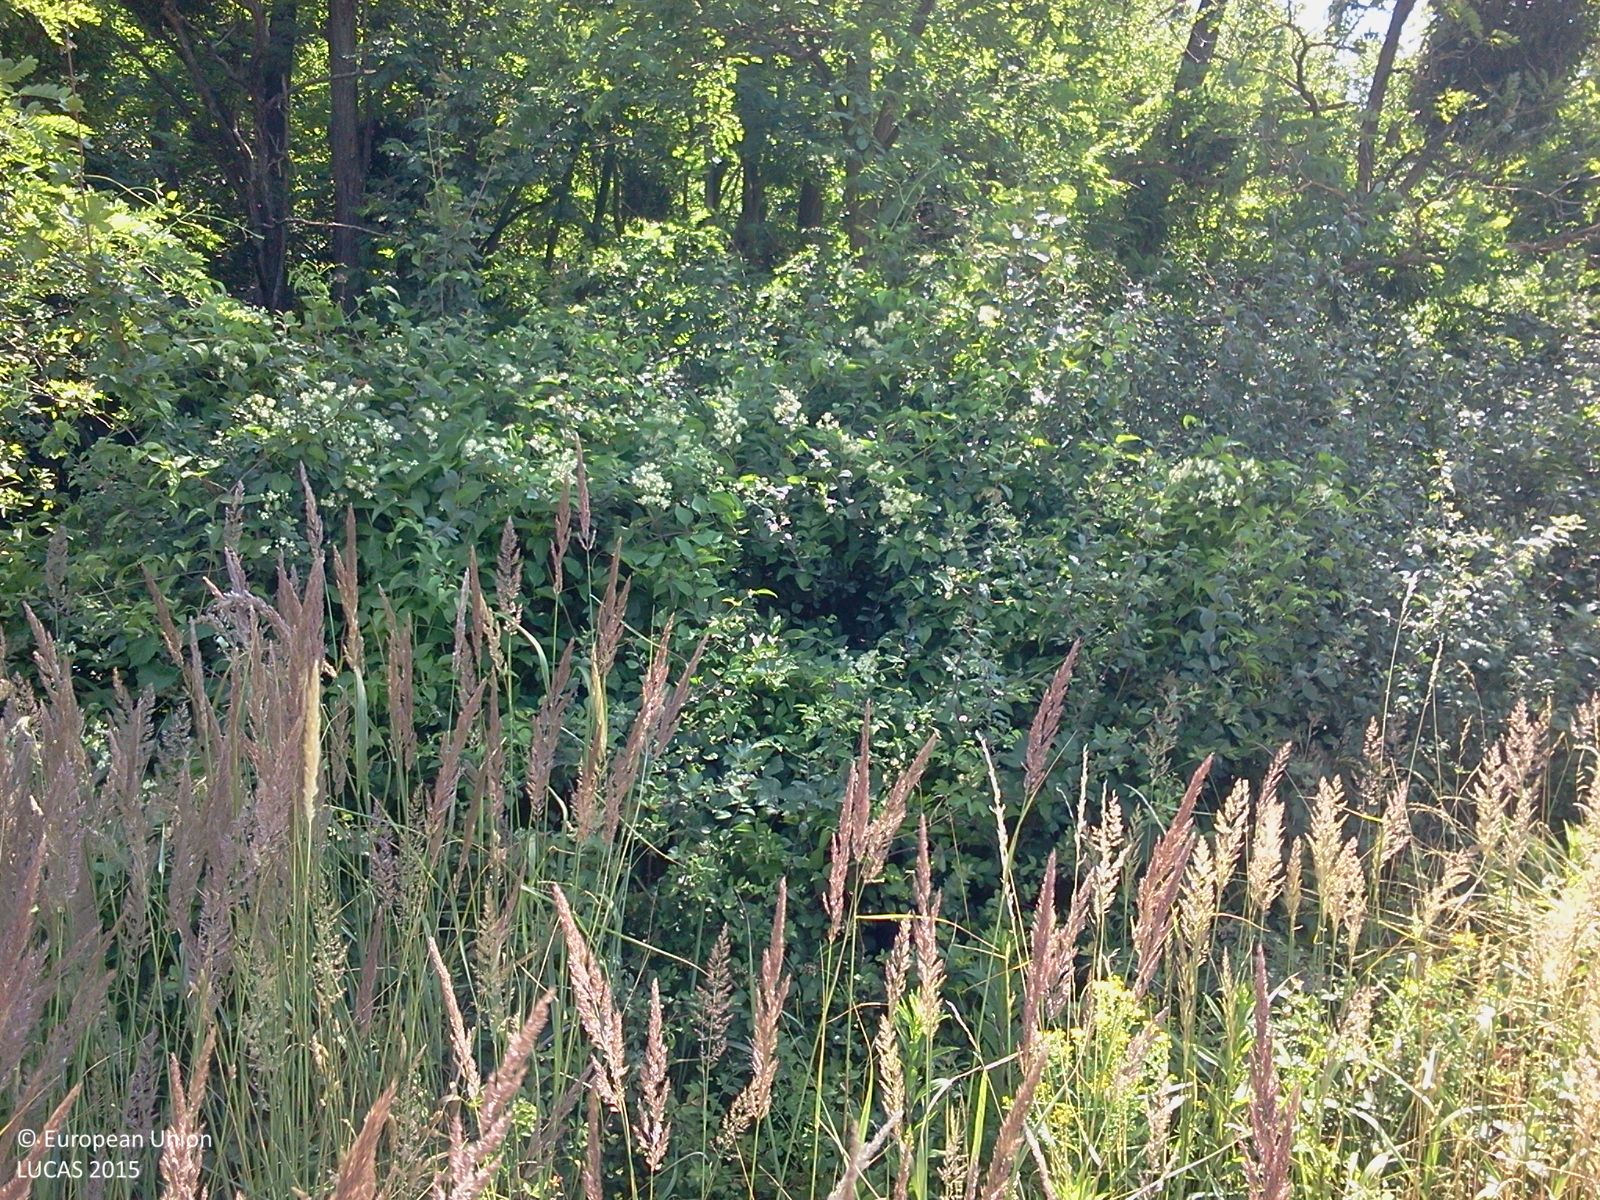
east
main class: Grassland
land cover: Grassland without tree/shrub cover
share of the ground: > 75 %
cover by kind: herbaceous plants 100 %
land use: Agriculture (excluding fallow land and kitchen gardens)
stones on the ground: < 10 %
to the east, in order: Grassland without tree/shrub cover; Broadleaved woodland; Grass margins; Tracks; Fences; Broadleaved woodland; Fences; Tracks; Broadleaved woodland
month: June
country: HU
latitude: 46.7667
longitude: 17.0880
